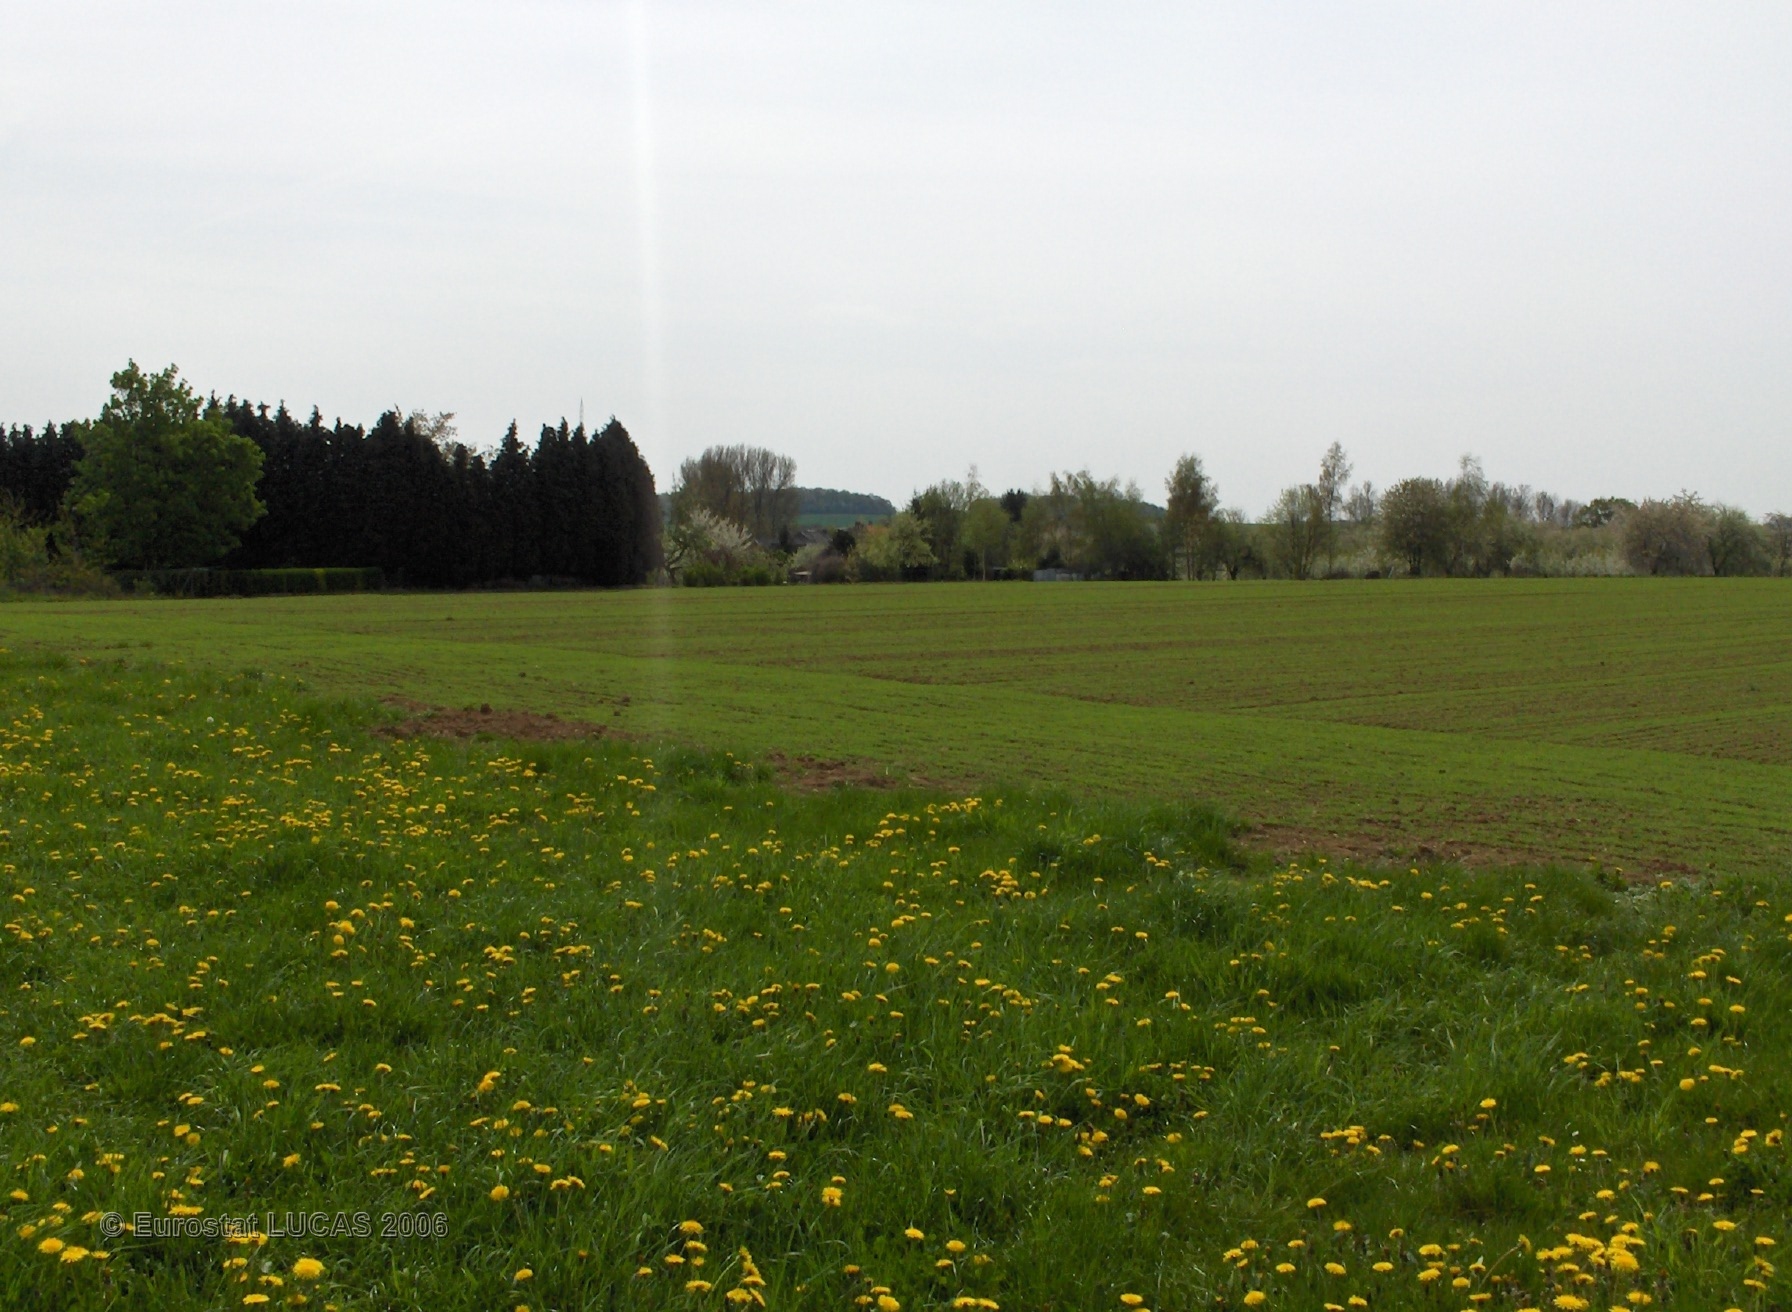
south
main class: Cropland
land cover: Other fibre and oleaginous crops
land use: Agriculture (excluding fallow land and kitchen gardens)
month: May
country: BE
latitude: 50.7338
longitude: 5.2512
